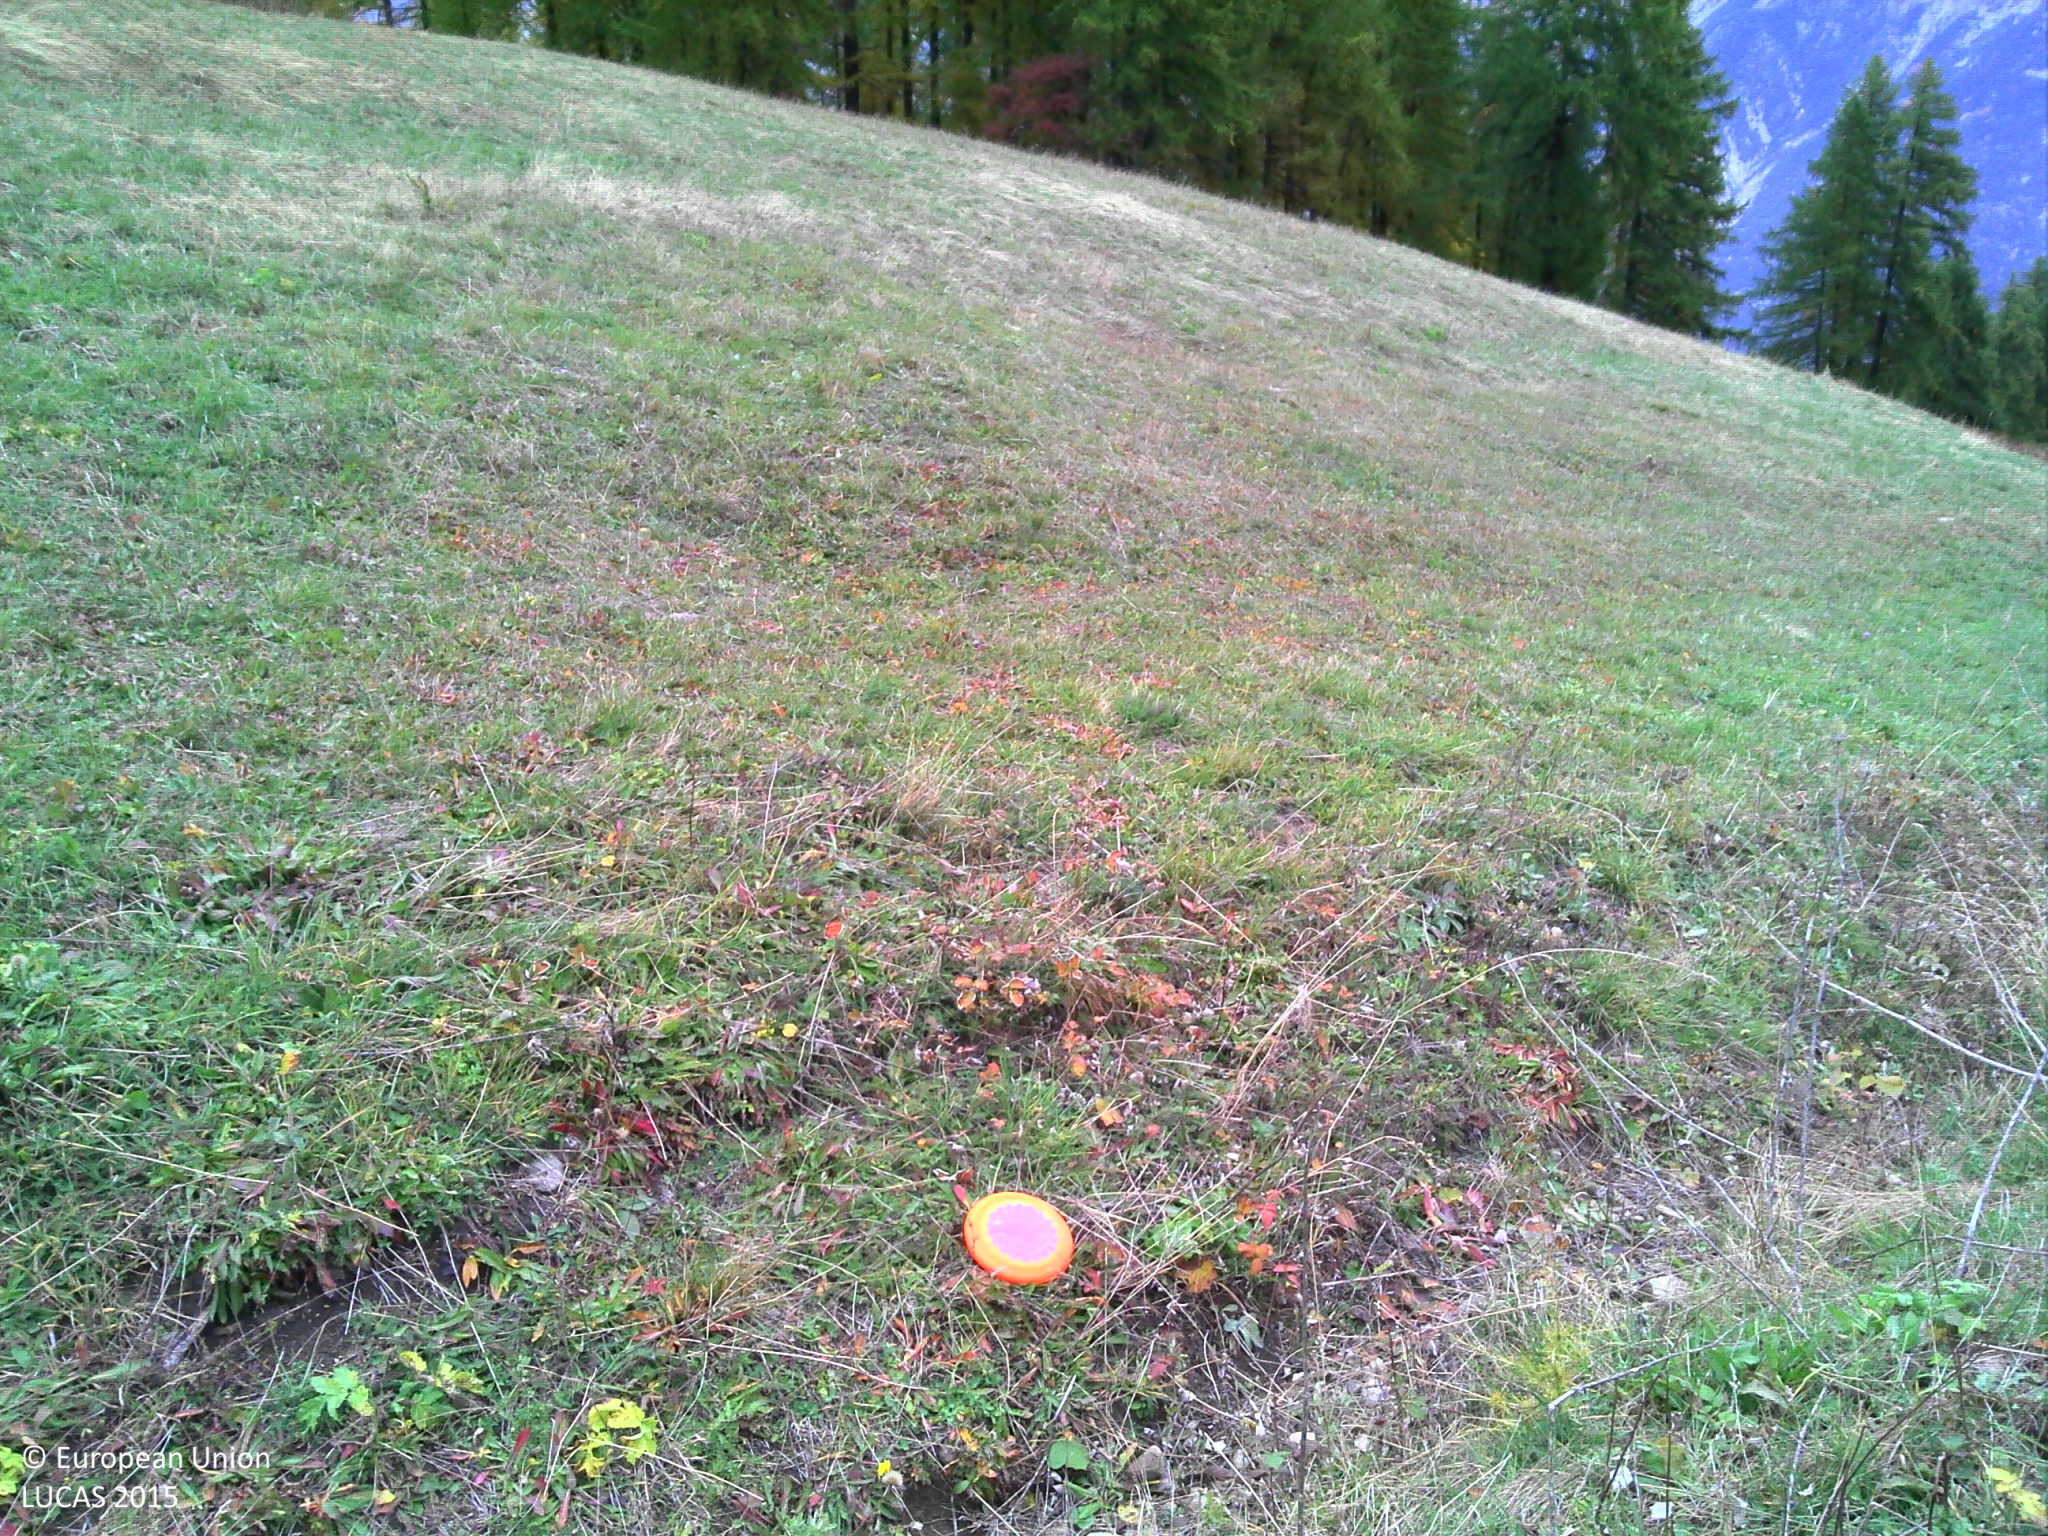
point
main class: Grassland
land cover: Grassland without tree/shrub cover
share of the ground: > 75 %
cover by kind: herbaceous plants 95 %, unconsolidated bare surface 5 %
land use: Agriculture (excluding fallow land and kitchen gardens)
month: October
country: FR
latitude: 44.8142
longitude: 6.4778
